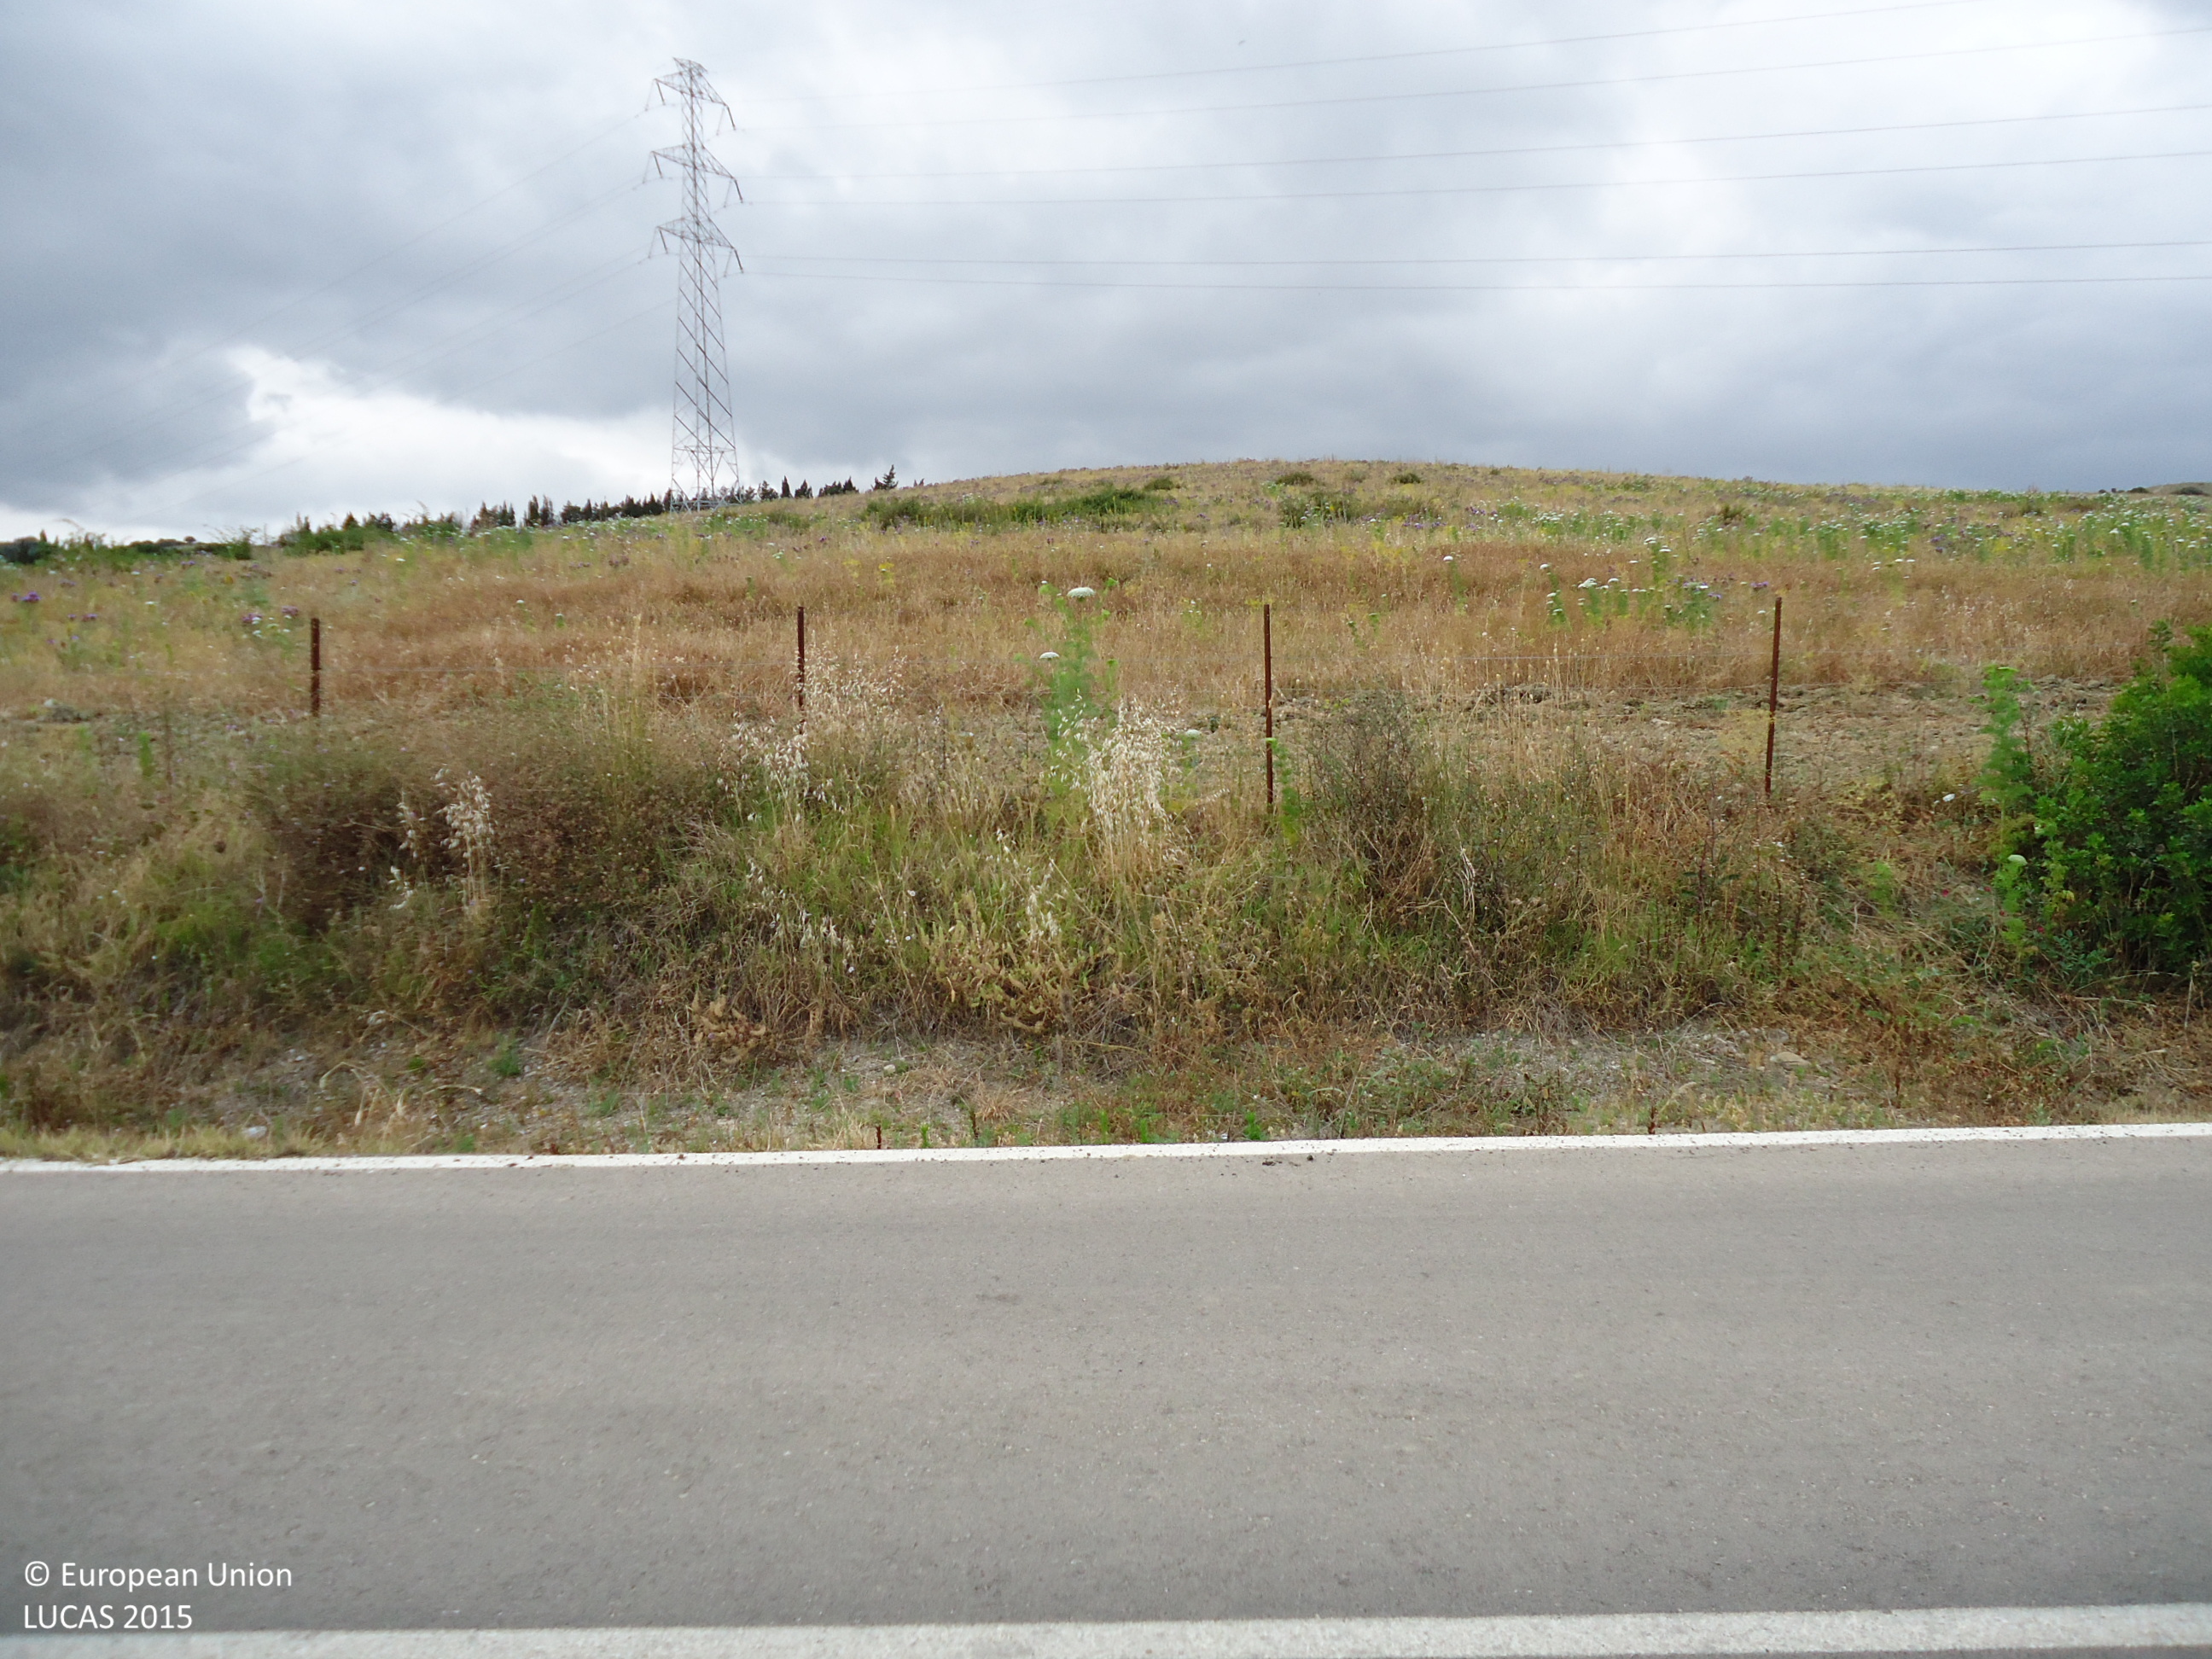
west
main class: Cropland
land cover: Lucerne
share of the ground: > 75 %
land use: Agriculture (excluding fallow land and kitchen gardens)
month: June
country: ES
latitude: 36.3693
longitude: -5.3194
